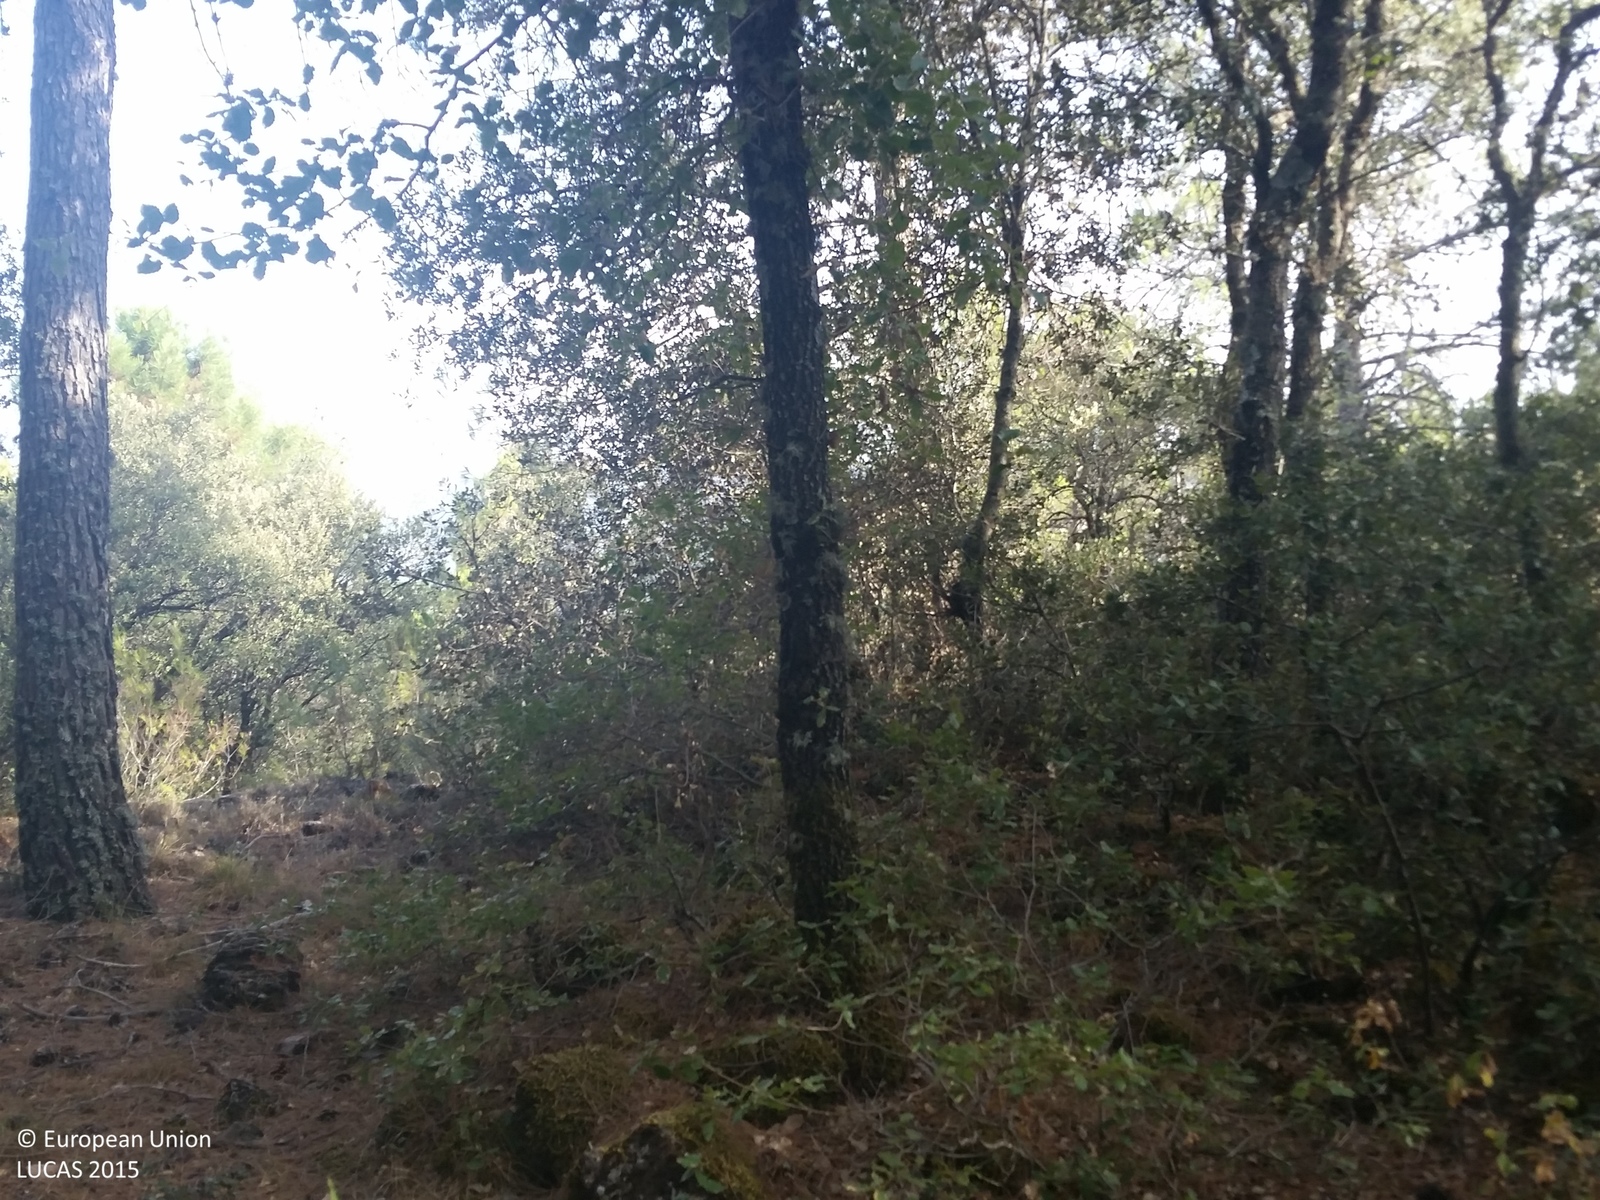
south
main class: Woodland
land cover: Pine dominated coniferous woodland
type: coniferous forest of the mediterranean region
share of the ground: > 75 %
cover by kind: coniferous forest trees 80 %, shrubs 20 %
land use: Forestry
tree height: > 5 m
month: August
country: ES
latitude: 38.5354
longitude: -2.6081
